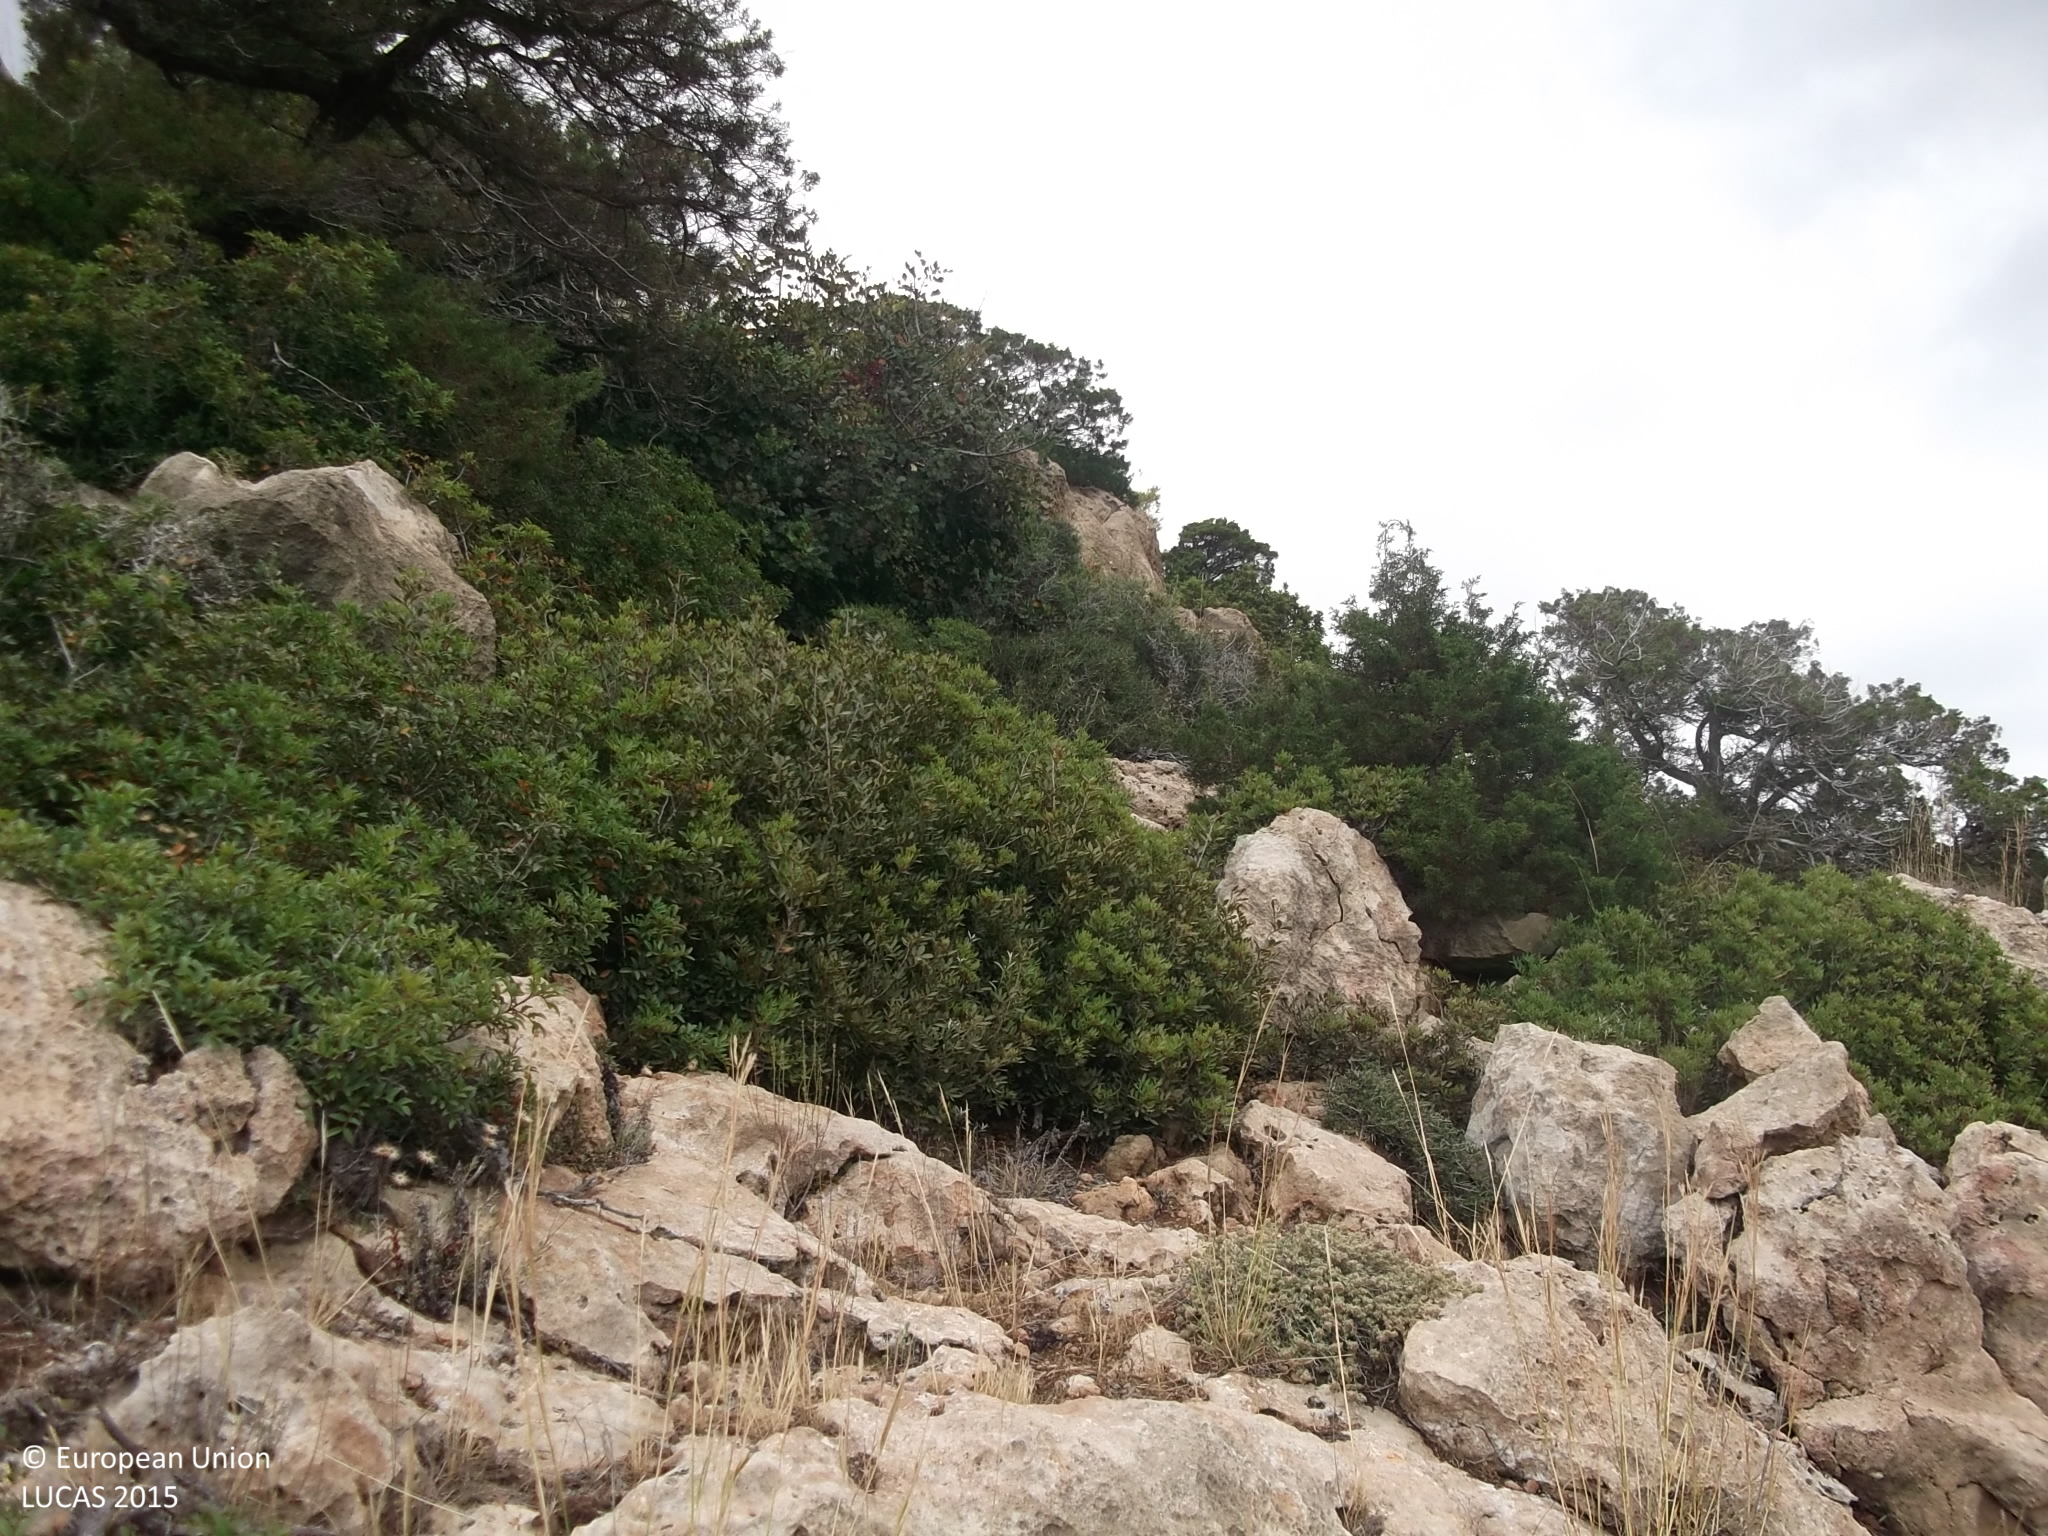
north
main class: Woodland
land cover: Other coniferous woodland
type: coniferous forest of the mediterranean region
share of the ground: 25 - 50 %
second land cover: Shrubland without tree cover
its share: 25 - 50 %
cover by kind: coniferous forest trees 30 %, shrubs 25 %, consolidated bare surface 25 %, unconsolidated bare surface 20 %
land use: Forestry
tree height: < 5 m
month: May
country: CY
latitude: 35.0038
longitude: 32.3148
